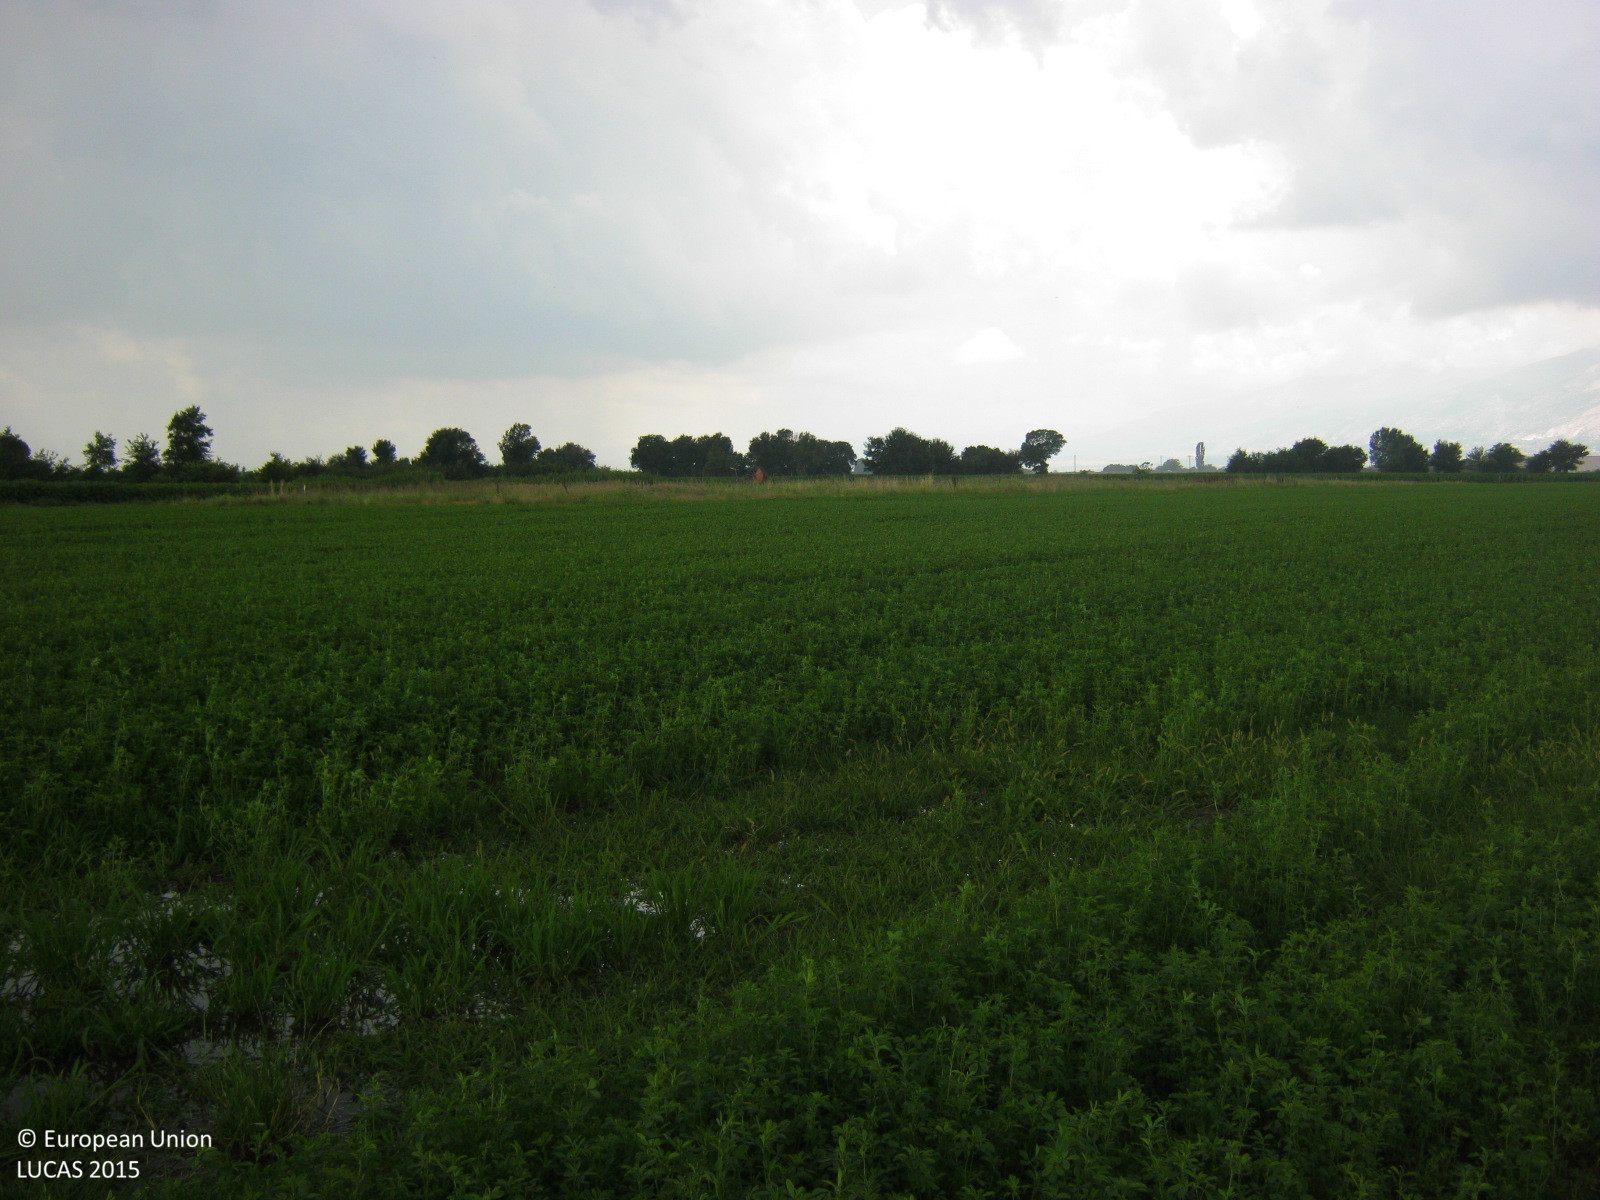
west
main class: Cropland
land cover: Lucerne
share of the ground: > 75 %
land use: Agriculture (excluding fallow land and kitchen gardens)
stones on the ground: < 10 %
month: June
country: GR
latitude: 41.1097
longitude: 24.9877
